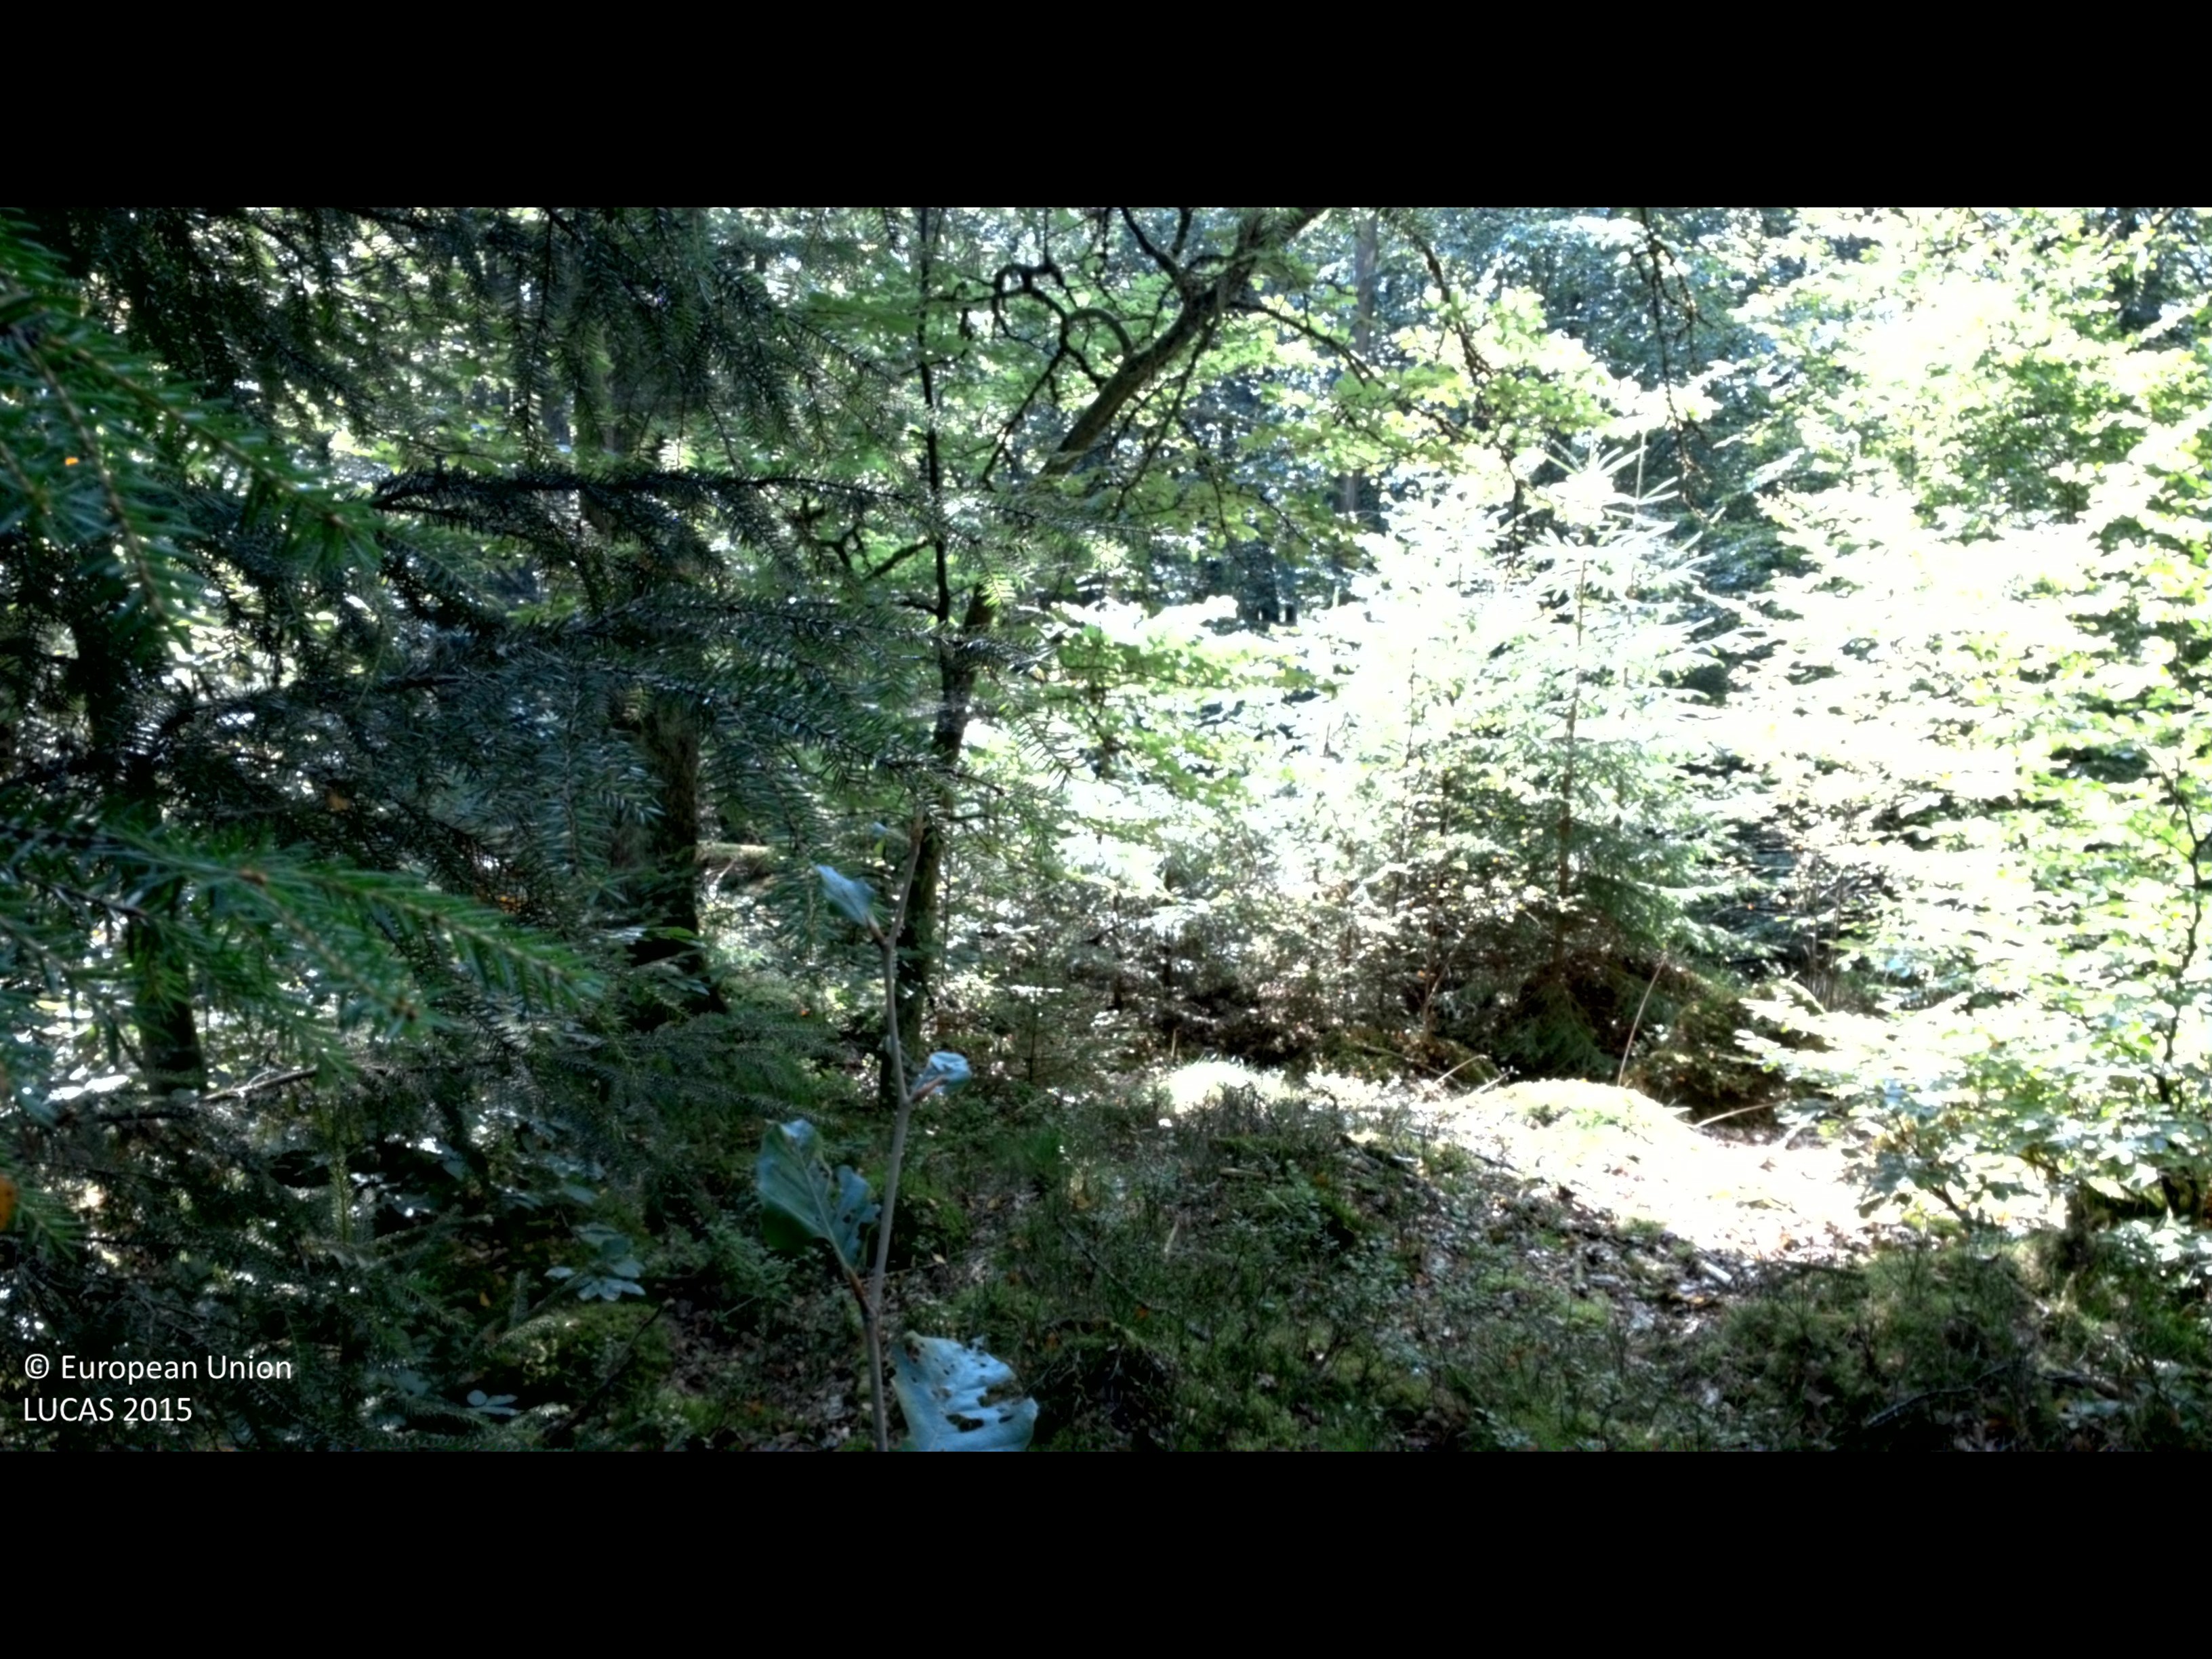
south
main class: Woodland
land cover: Broadleaved woodland
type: hemiboreal forest and nemoral coniferous forest and mixed broadleaved-coniferous forest
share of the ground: > 75 %
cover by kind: broadleaved forest trees 85 %, shrubs 10 %, coniferous forest trees 5 %
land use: Forestry
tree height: > 5 m
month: August
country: SE
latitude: 56.8849
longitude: 13.2297
